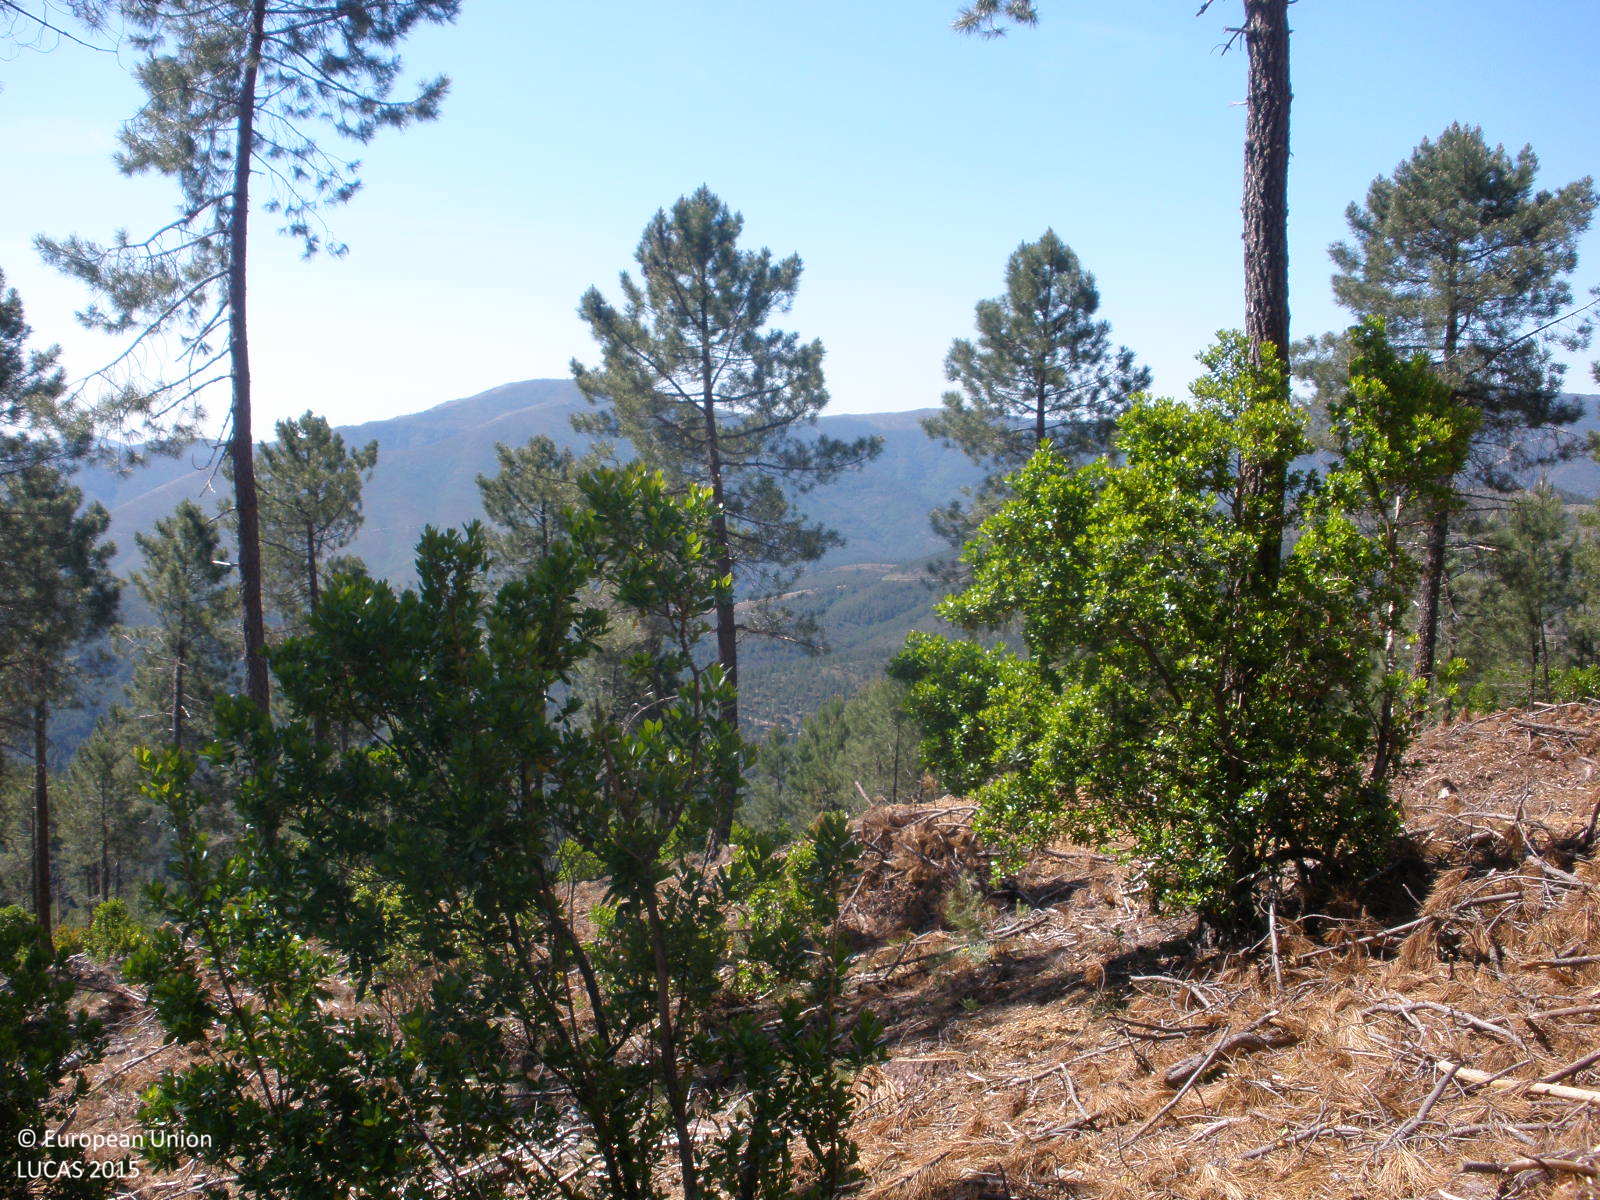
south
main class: Woodland
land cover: Pine dominated coniferous woodland
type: coniferous forest of the mediterranean region
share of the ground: > 75 %
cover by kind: coniferous forest trees 40 %, shrubs 30 %, consolidated bare surface 30 %
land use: Forestry
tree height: > 5 m
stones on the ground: < 10 %
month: May
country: ES
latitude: 40.4492
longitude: -6.2466
